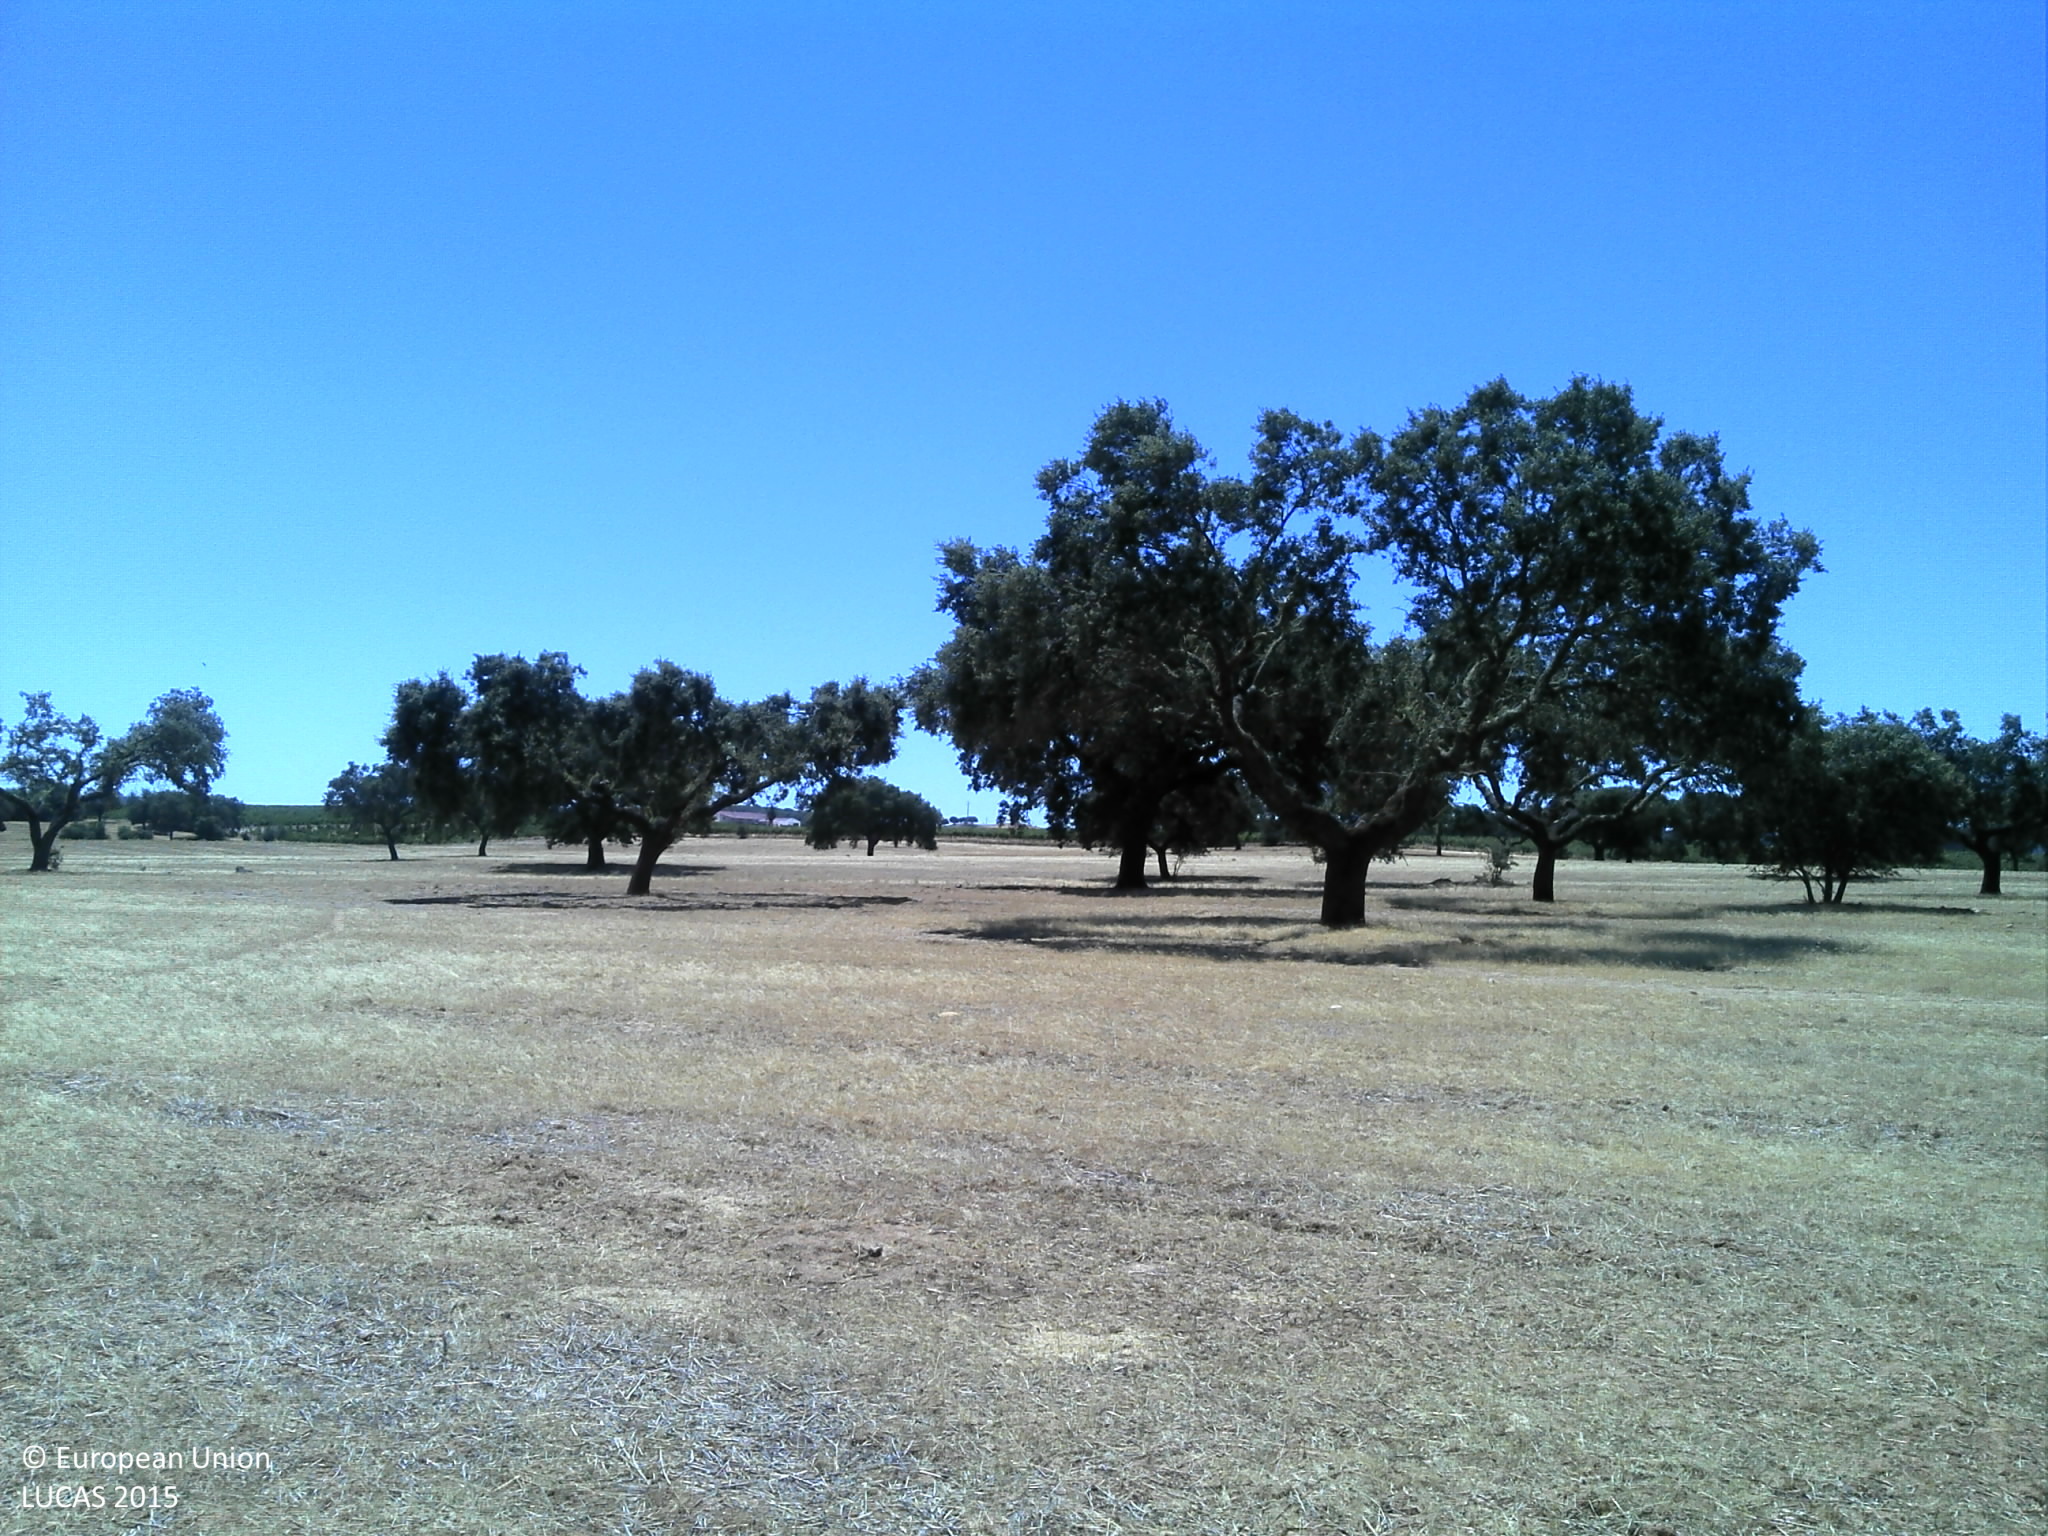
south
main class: Grassland
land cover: Grassland without tree/shrub cover
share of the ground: 10 - 25 %
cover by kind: unconsolidated bare surface 80 %, herbaceous plants 20 %
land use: Agriculture (excluding fallow land and kitchen gardens)
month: July
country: PT
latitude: 38.8836
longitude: -7.5003
